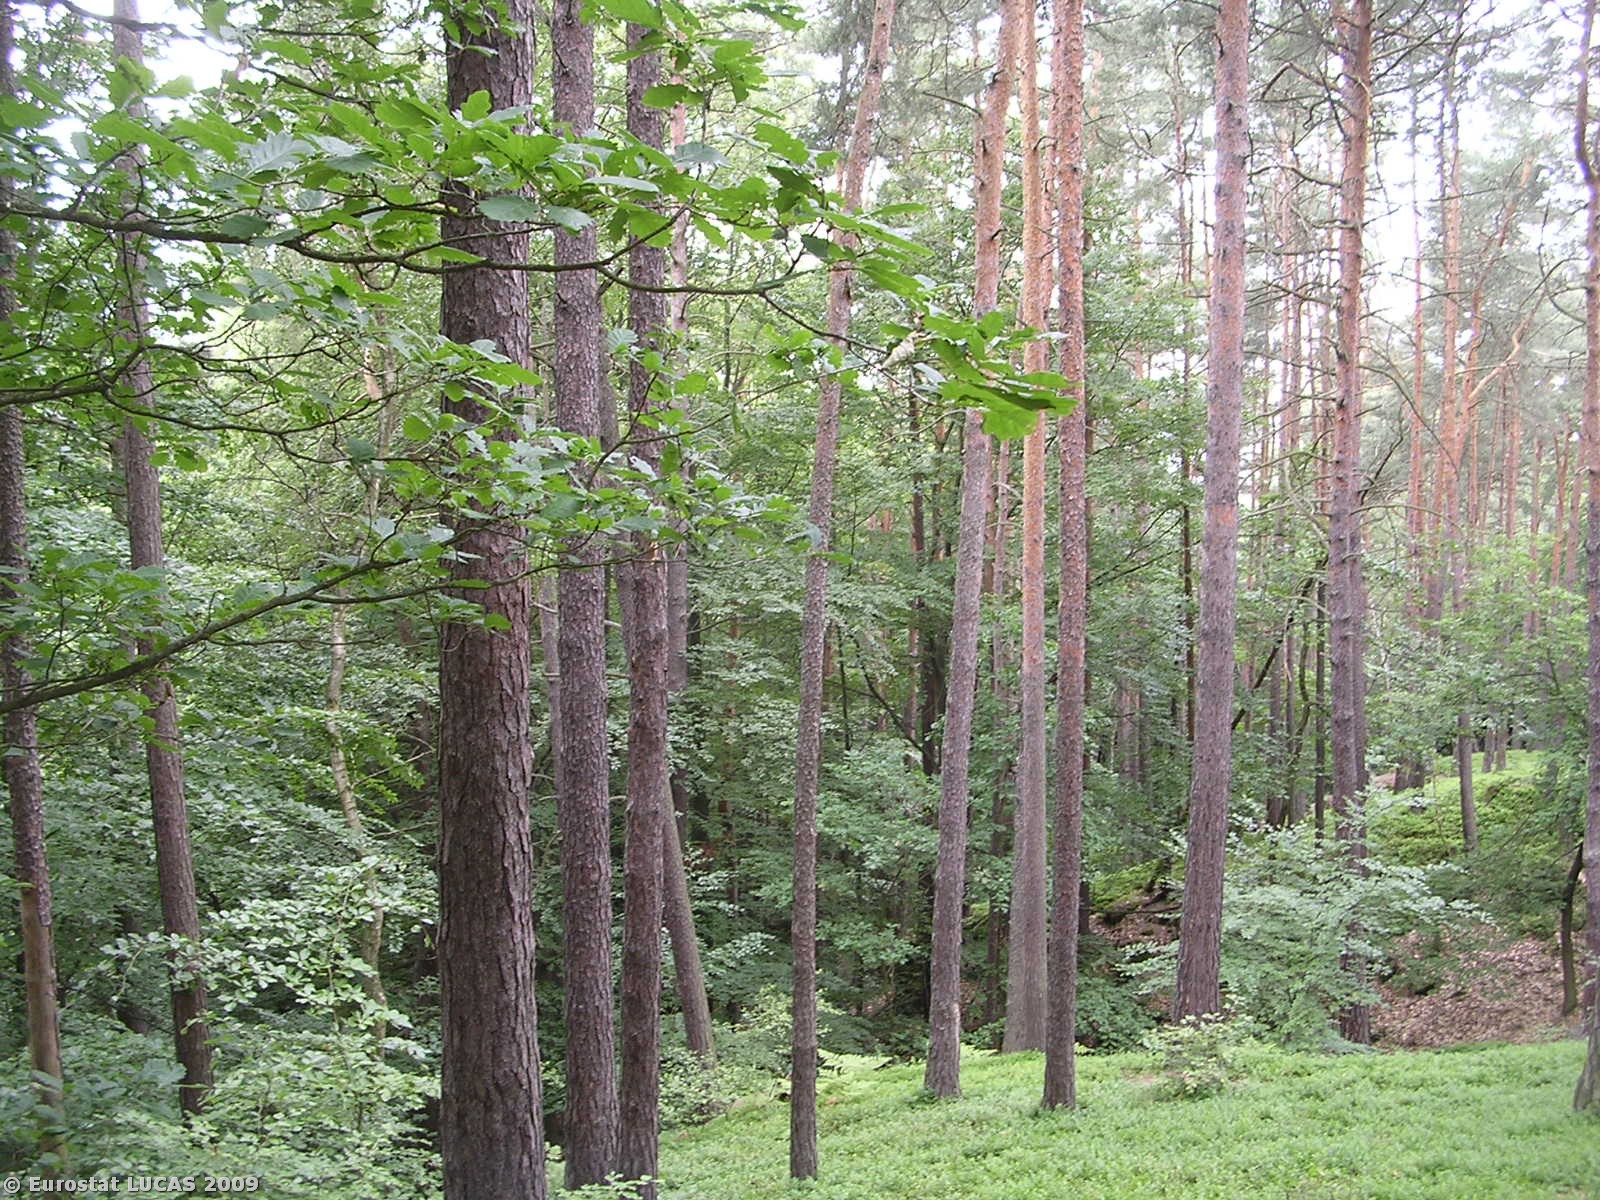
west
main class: Woodland
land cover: Mixed woodland
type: hemiboreal forest and nemoral coniferous forest and mixed broadleaved-coniferous forest
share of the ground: > 75 %
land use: Forestry
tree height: > 5 m
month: June
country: CZ
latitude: 50.5086
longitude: 14.5282
